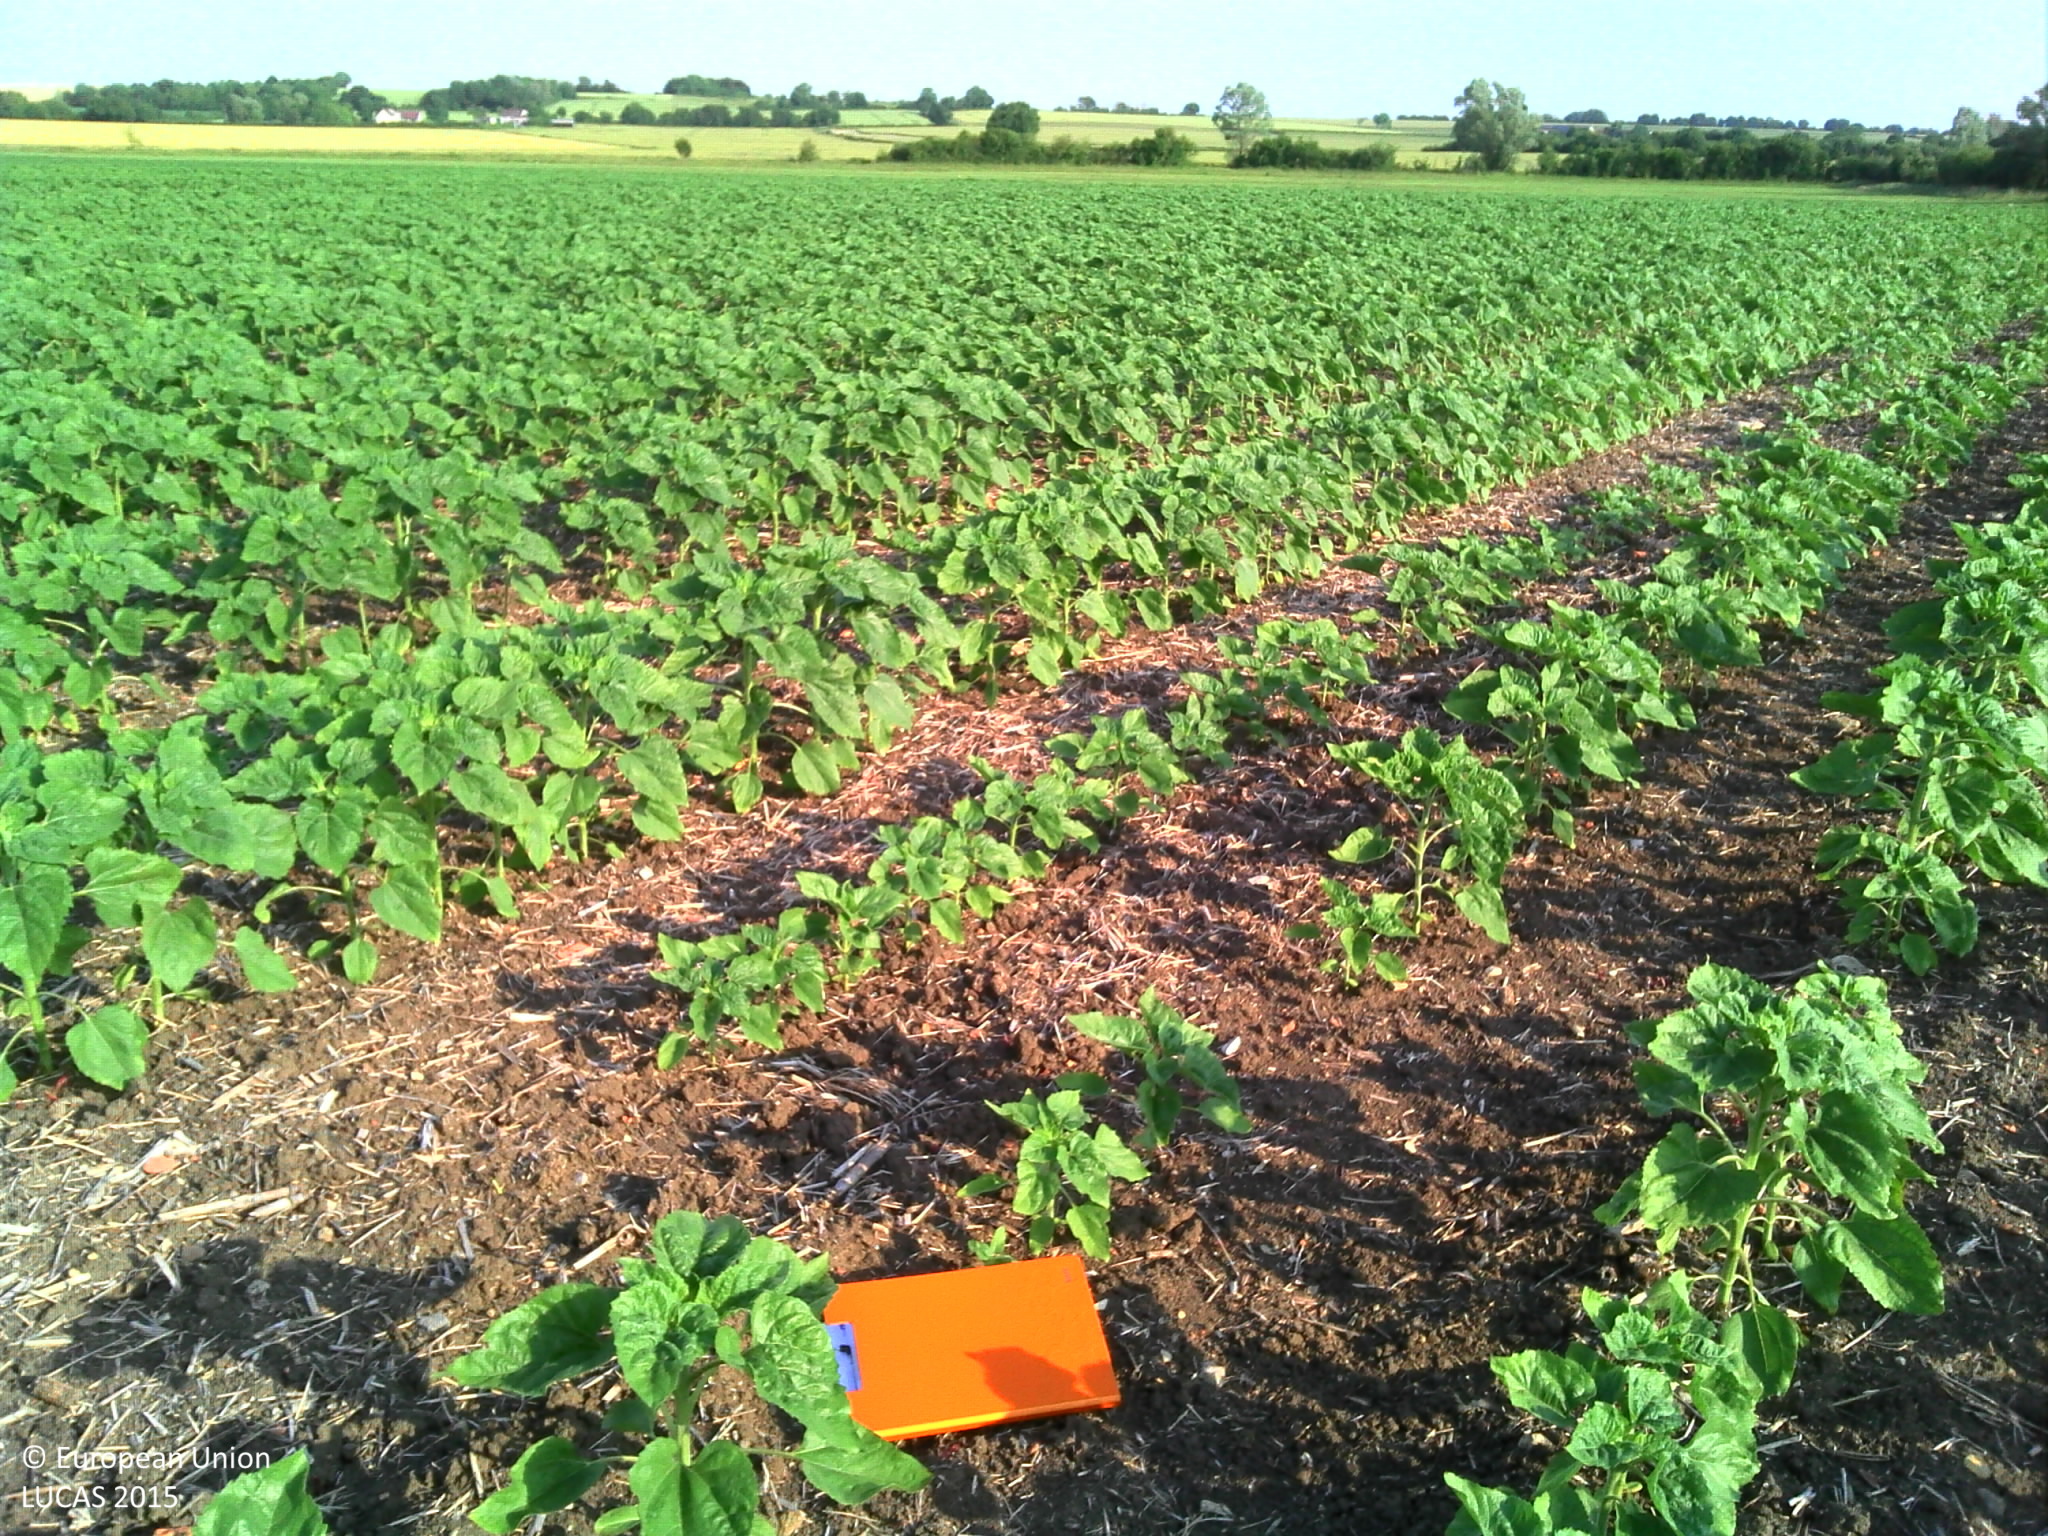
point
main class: Cropland
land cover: Sunflower
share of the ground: > 75 %
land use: Agriculture (excluding fallow land and kitchen gardens)
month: June
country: FR
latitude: 46.8763
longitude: 2.6600
